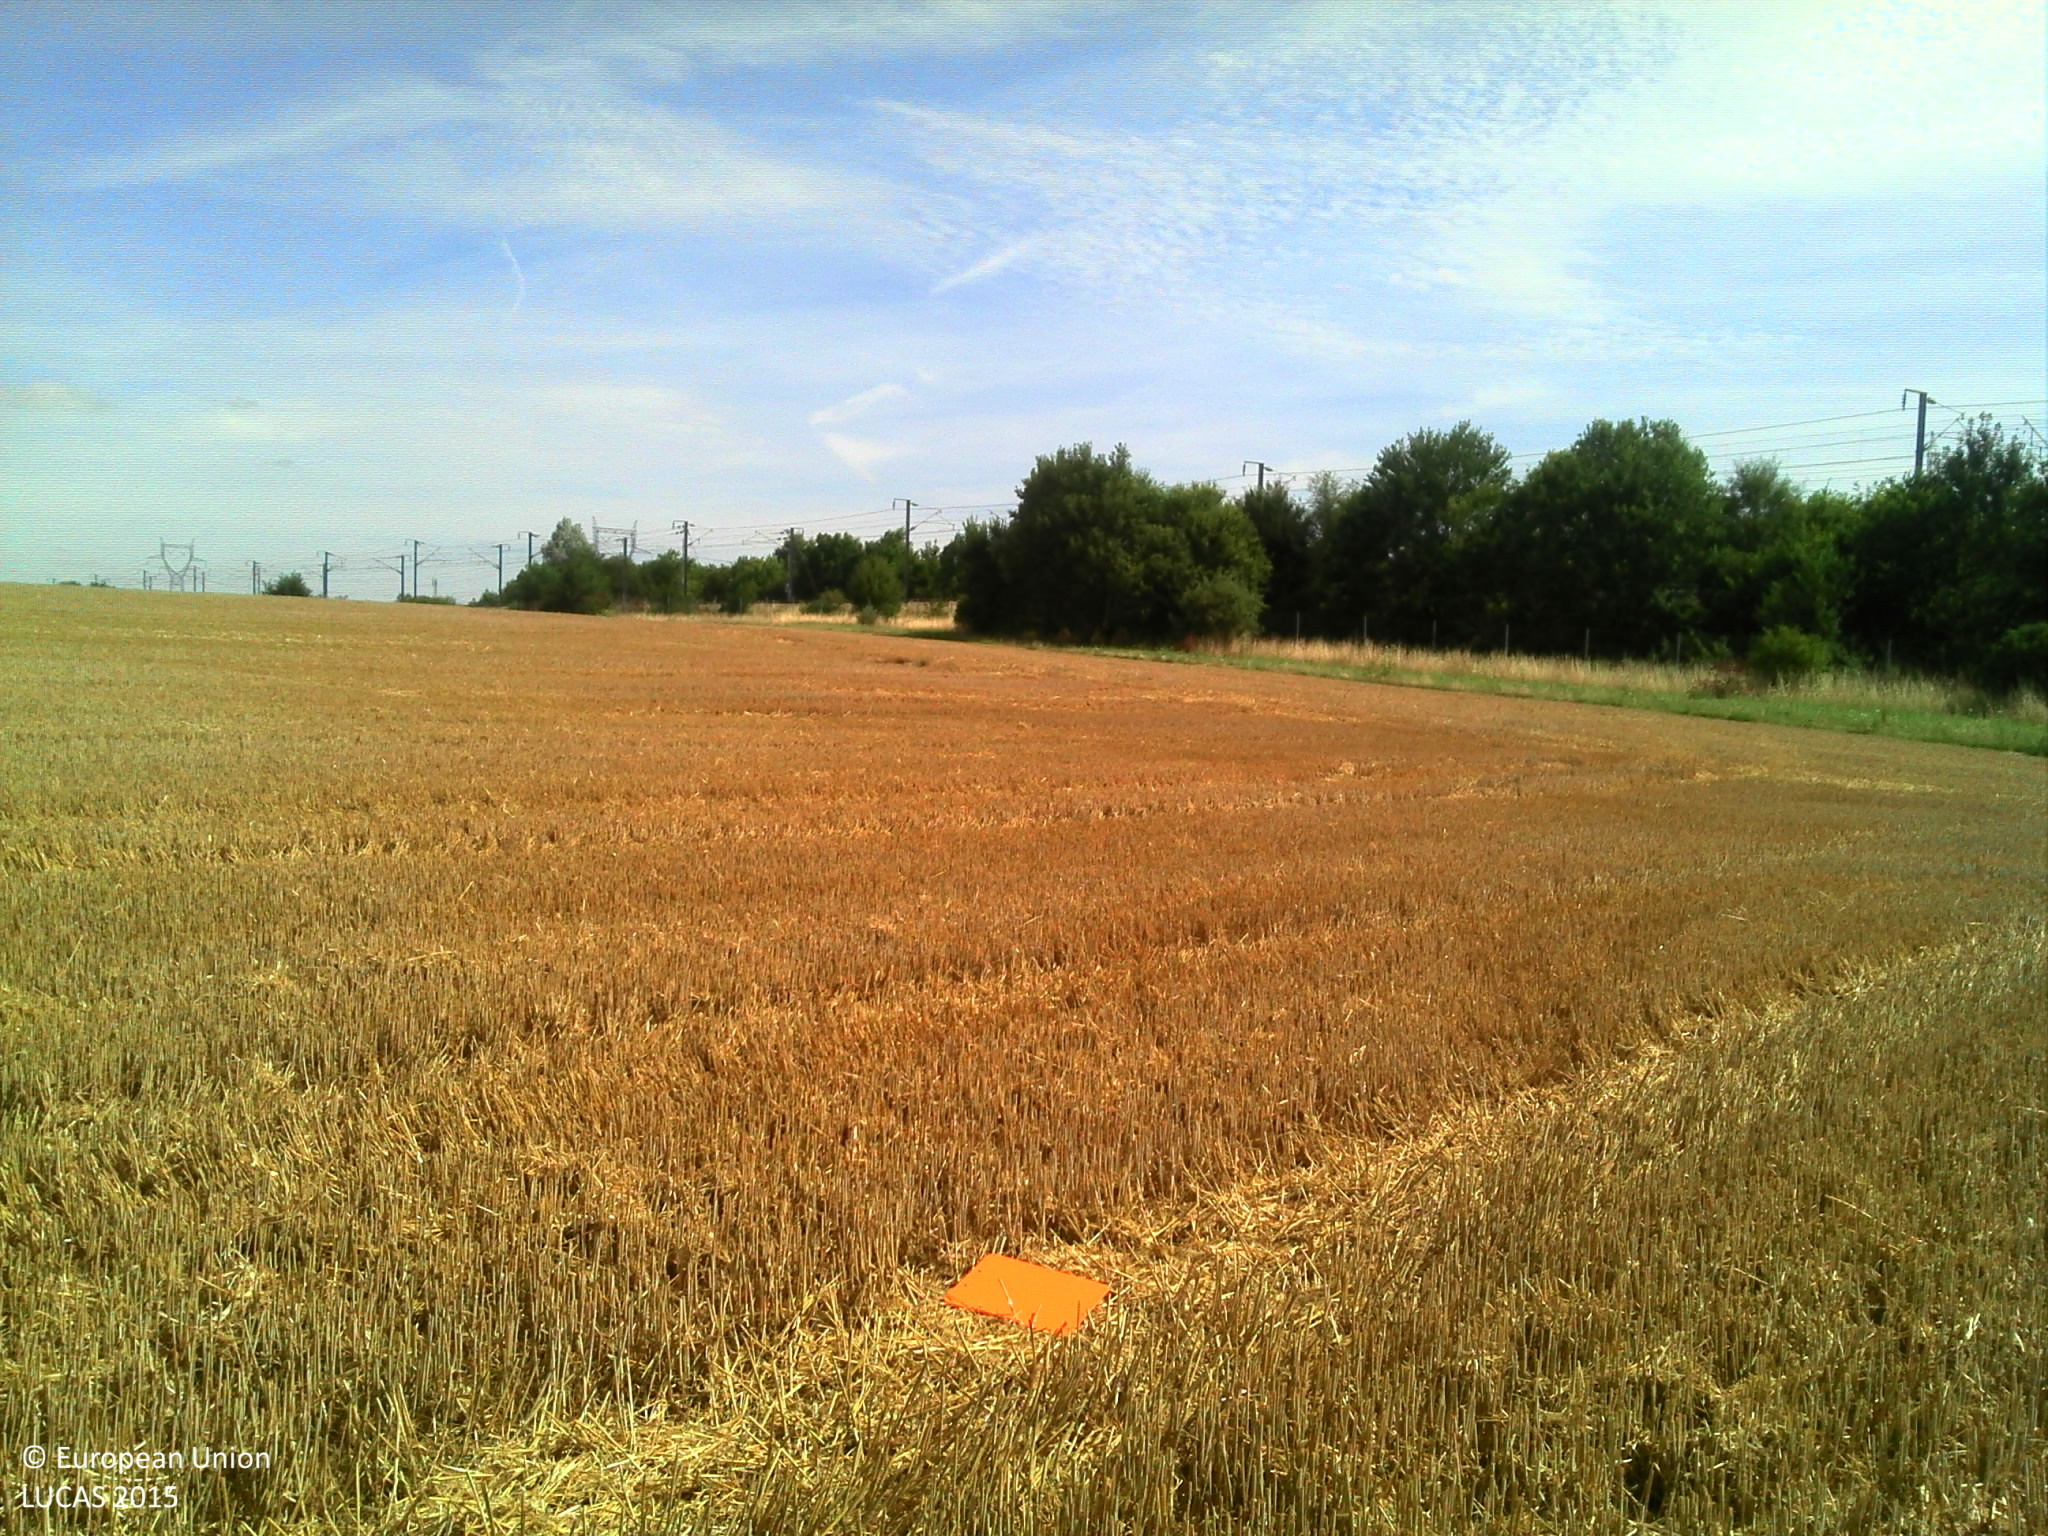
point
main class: Cropland
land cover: Common wheat
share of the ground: > 75 %
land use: Agriculture (excluding fallow land and kitchen gardens)
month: August
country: FR
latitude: 49.9053
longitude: 2.8467
